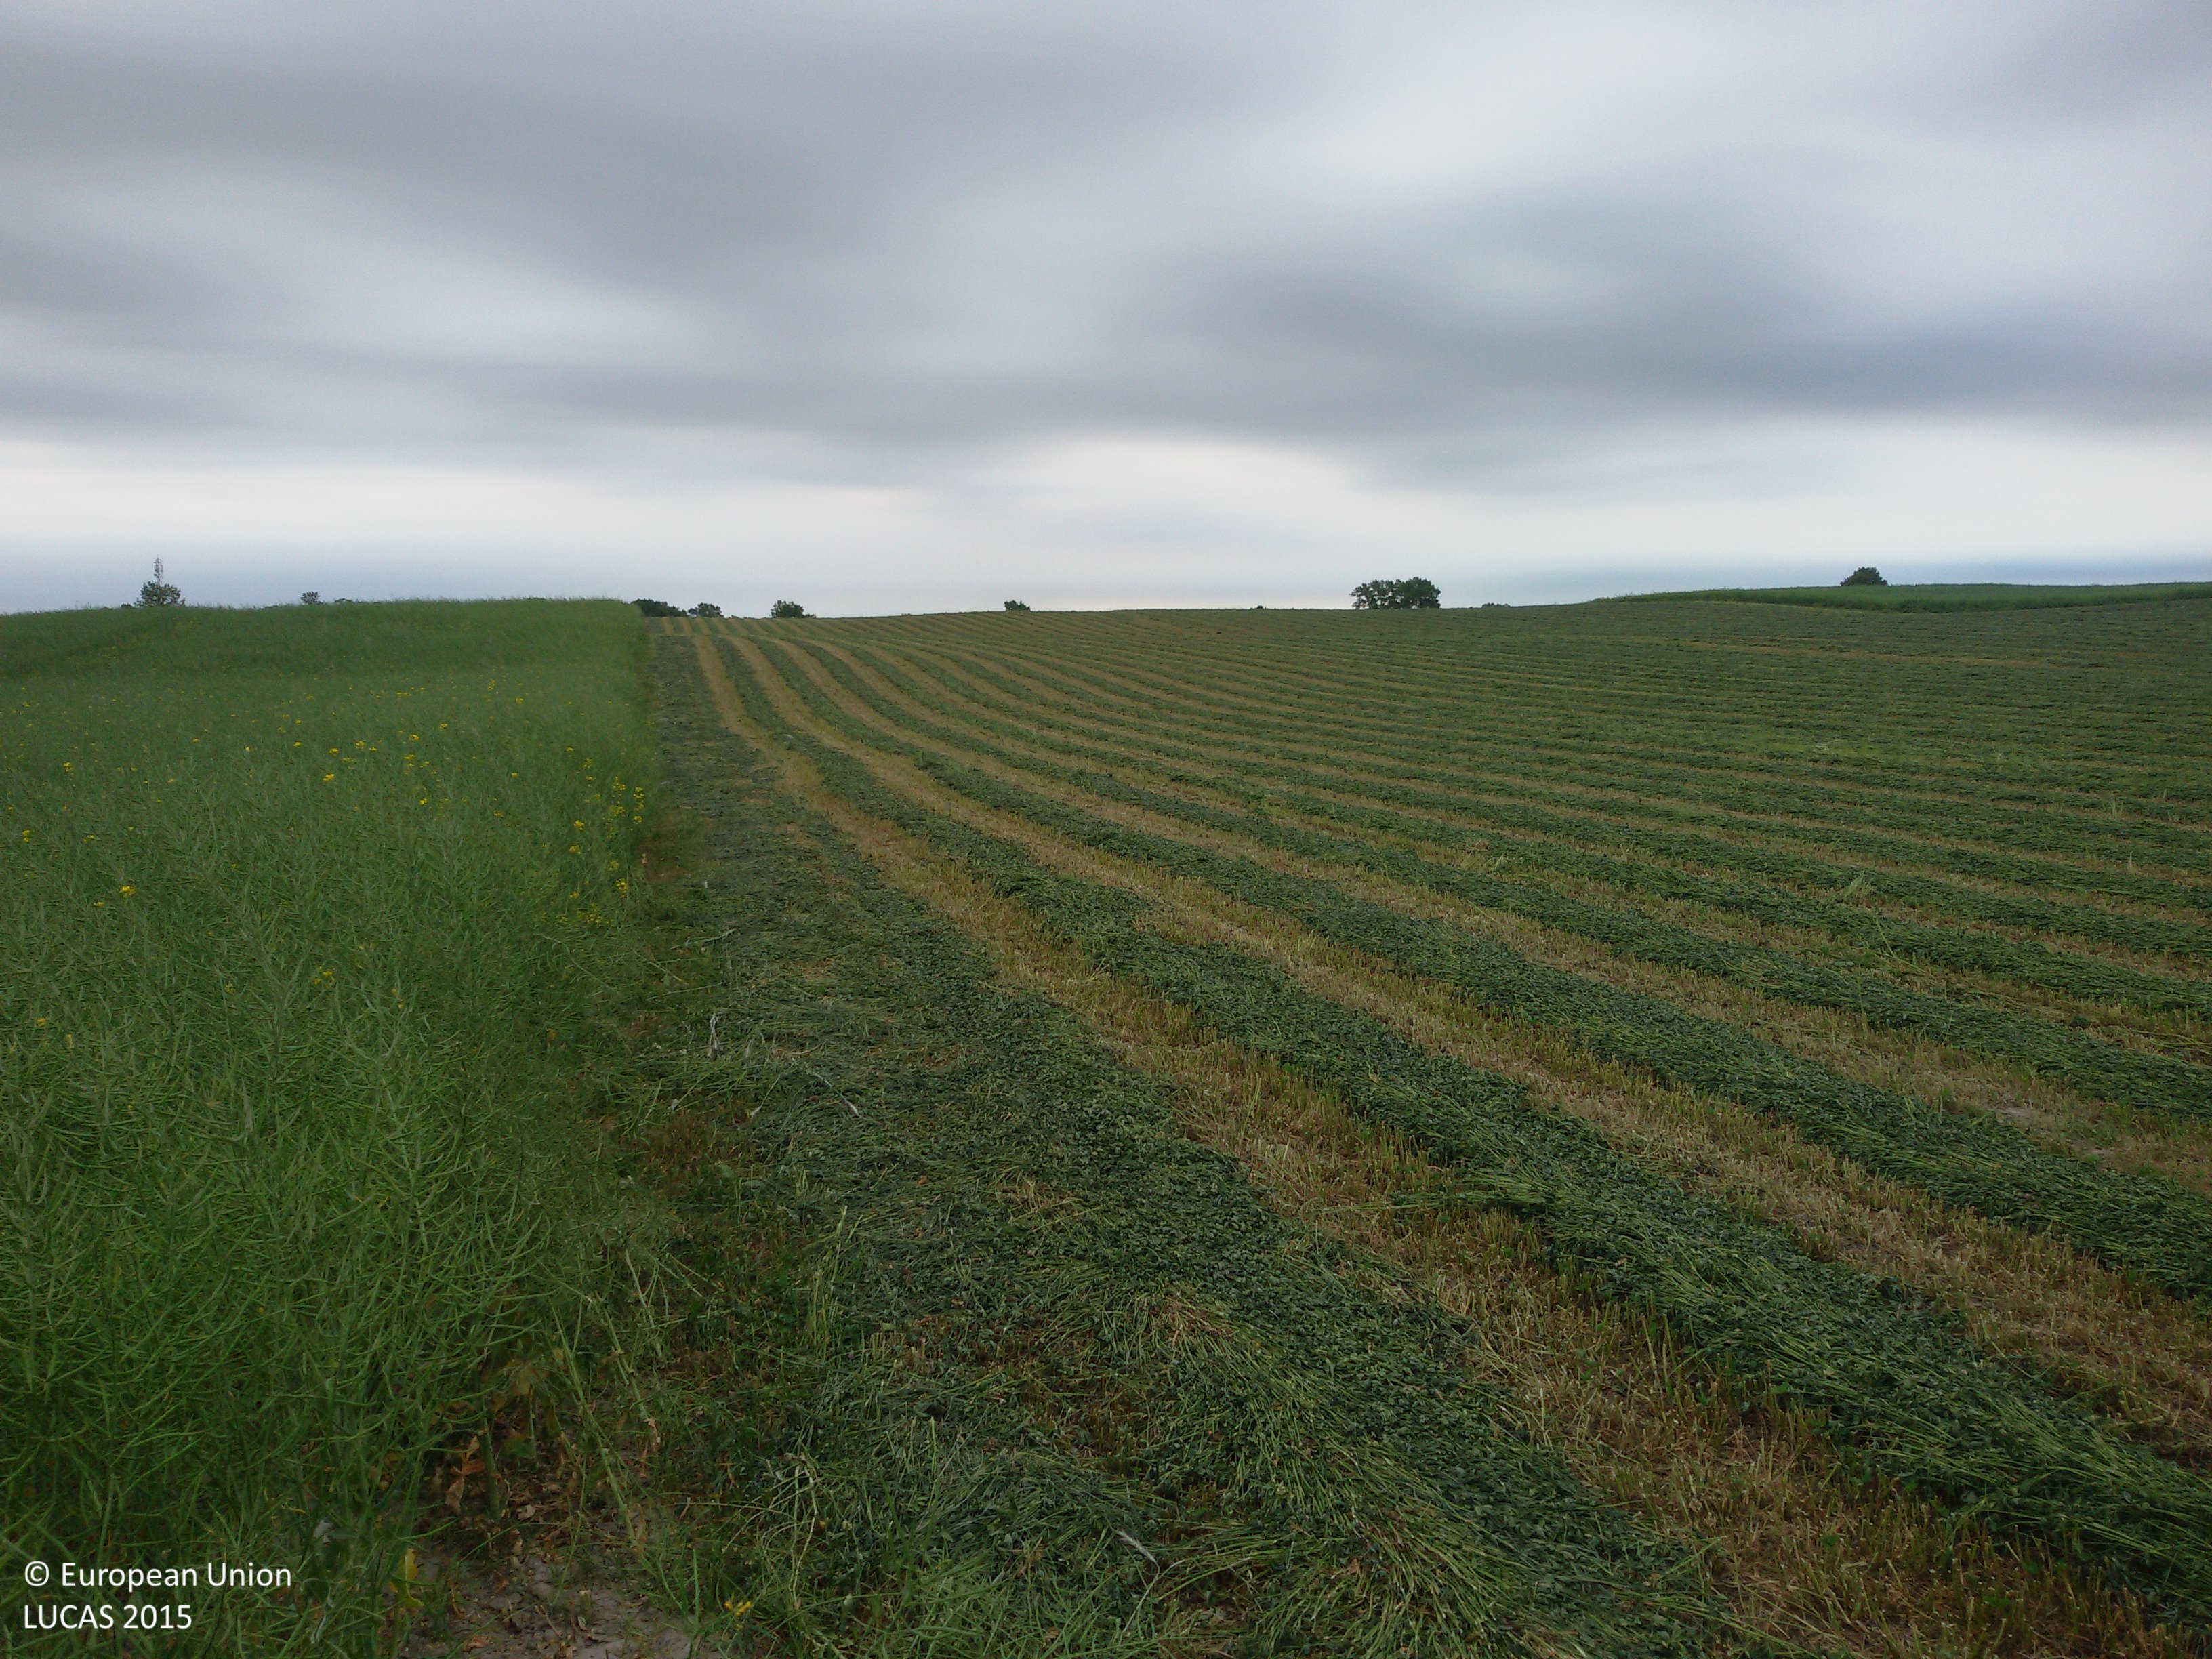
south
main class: Cropland
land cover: Rape and turnip rape
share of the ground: > 75 %
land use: Agriculture (excluding fallow land and kitchen gardens)
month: June
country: PL
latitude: 53.2112
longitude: 17.6947
